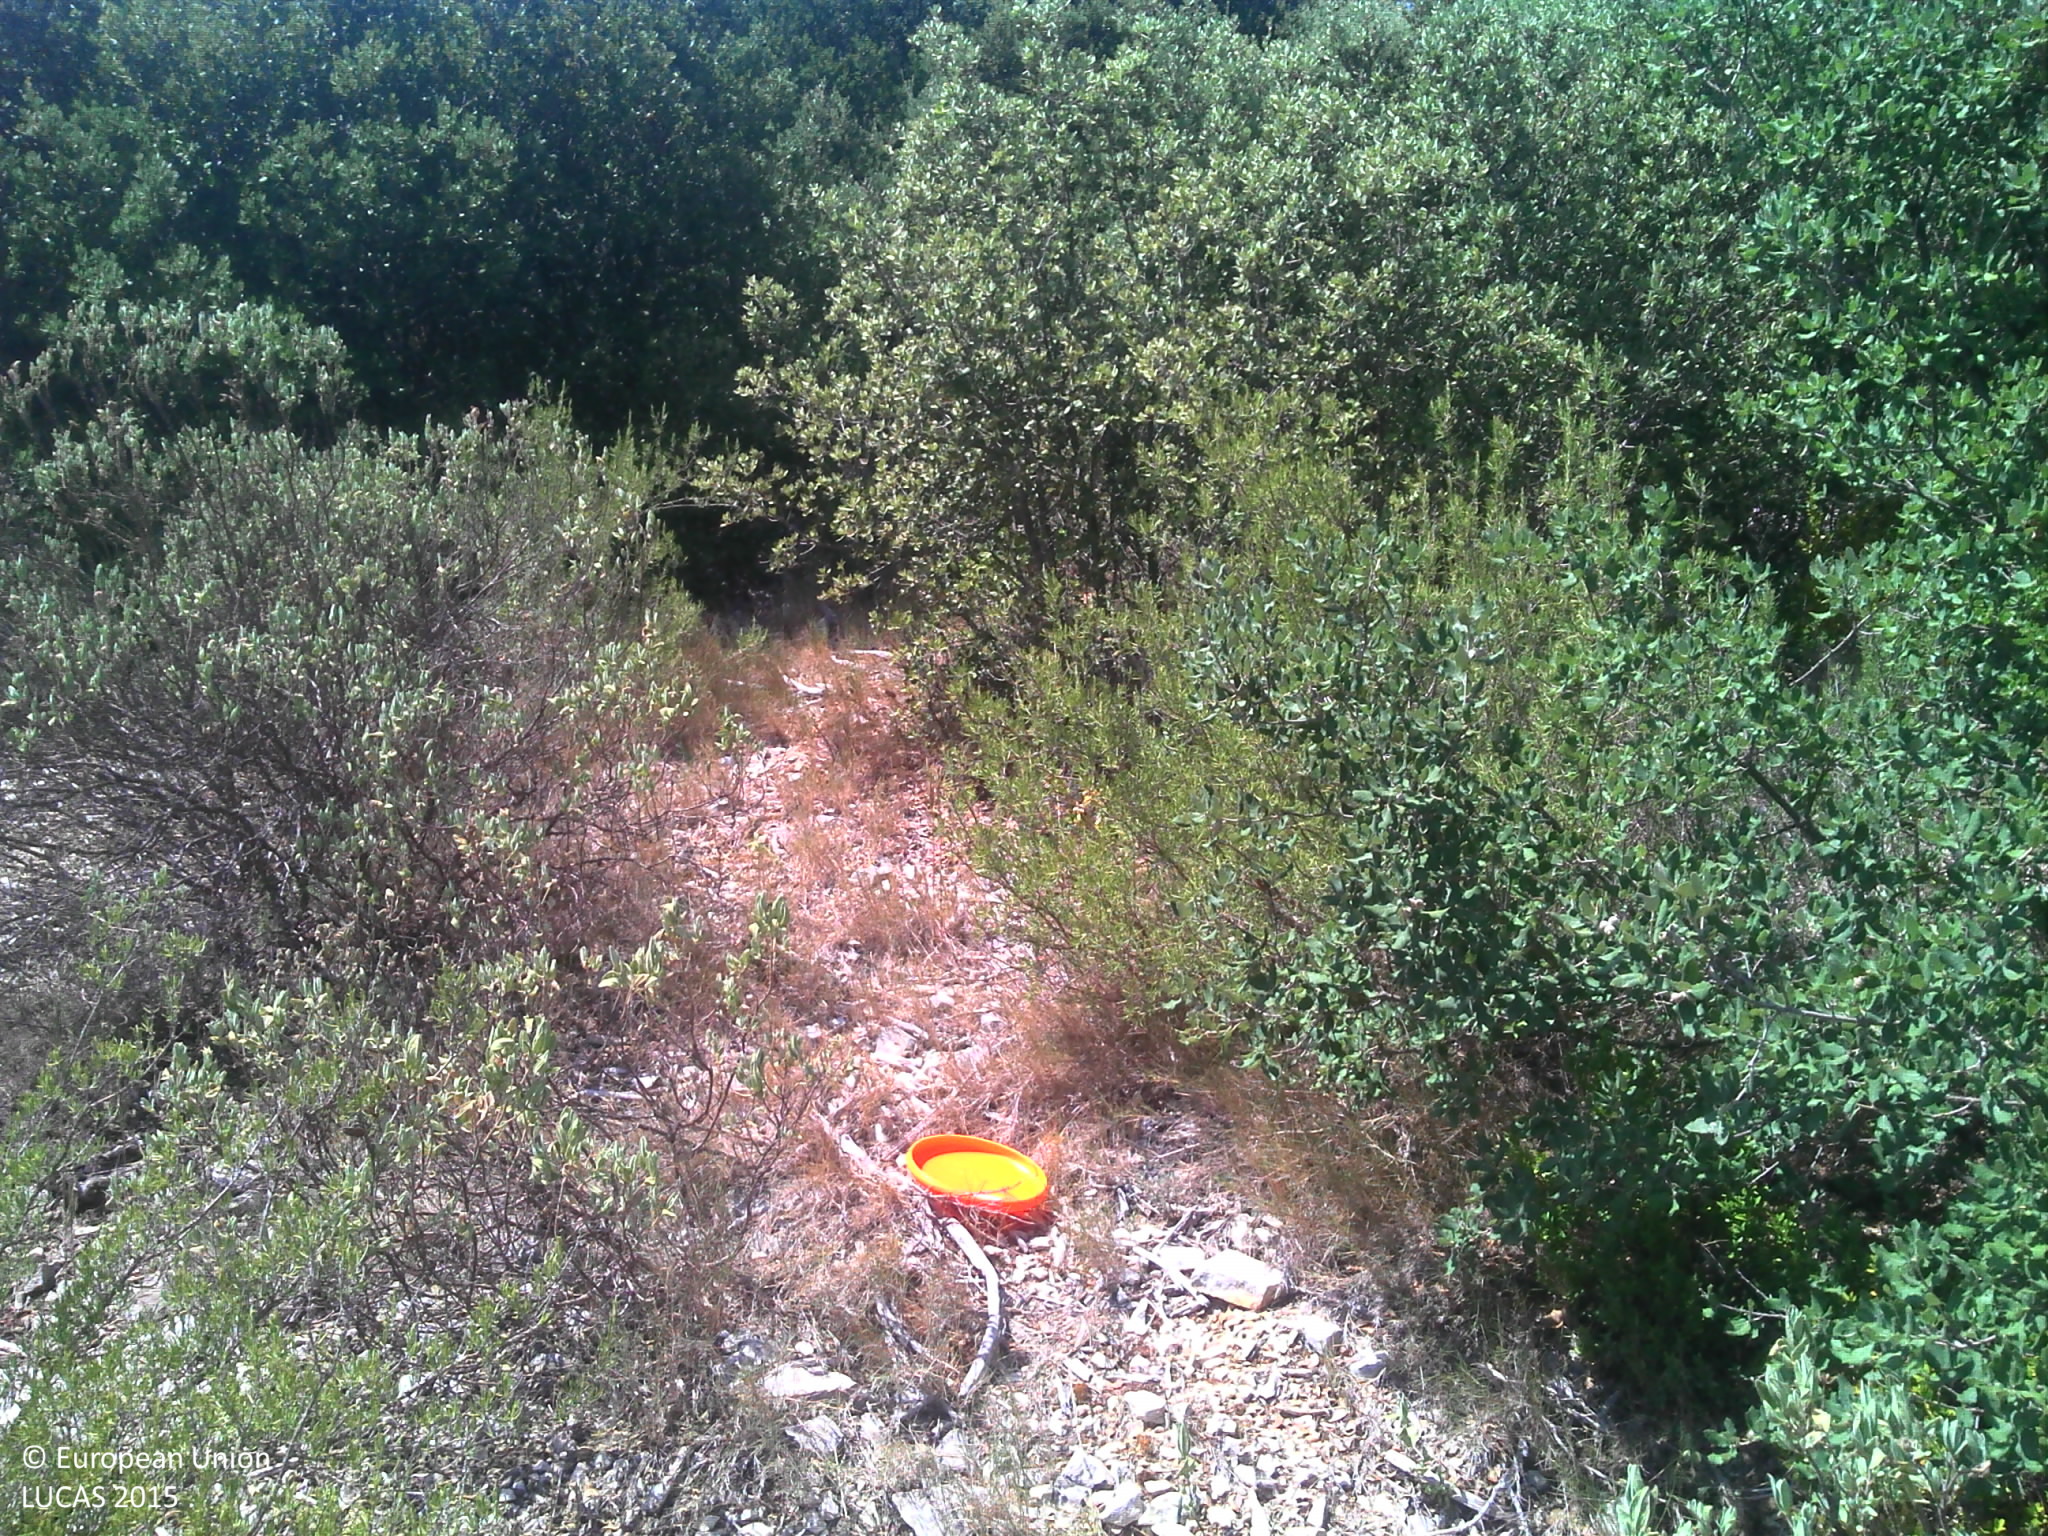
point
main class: Shrubland
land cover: Shrubland with sparse tree cover
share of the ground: > 75 %
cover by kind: shrubs 40 %, herbaceous plants 25 %, unconsolidated bare surface 25 %, broadleaved forest trees 5 %, consolidated bare surface 5 %
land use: Forestry
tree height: < 5 m
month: August
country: FR
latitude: 43.6666
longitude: 5.7305
